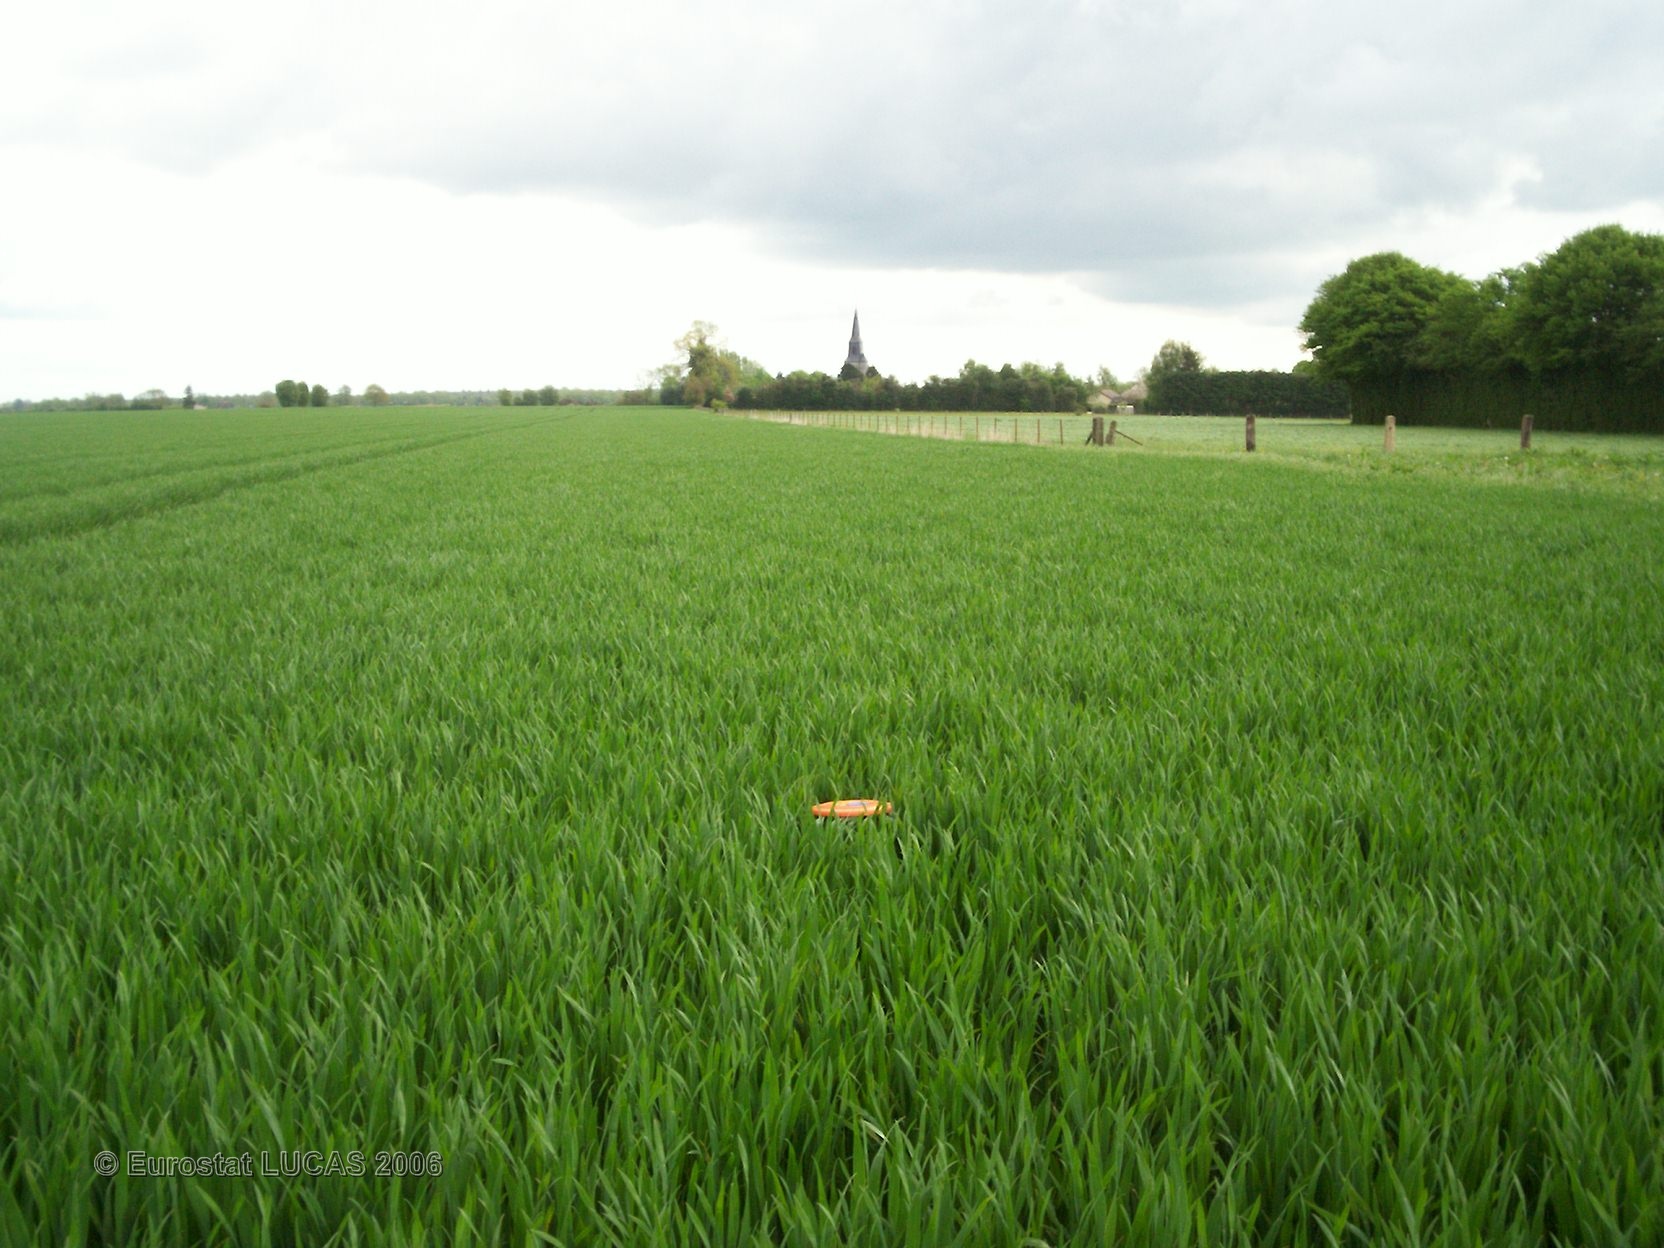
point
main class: Cropland
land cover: Common wheat
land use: Agriculture (excluding fallow land and kitchen gardens)
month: May
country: FR
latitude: 49.0460
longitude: 0.5203
